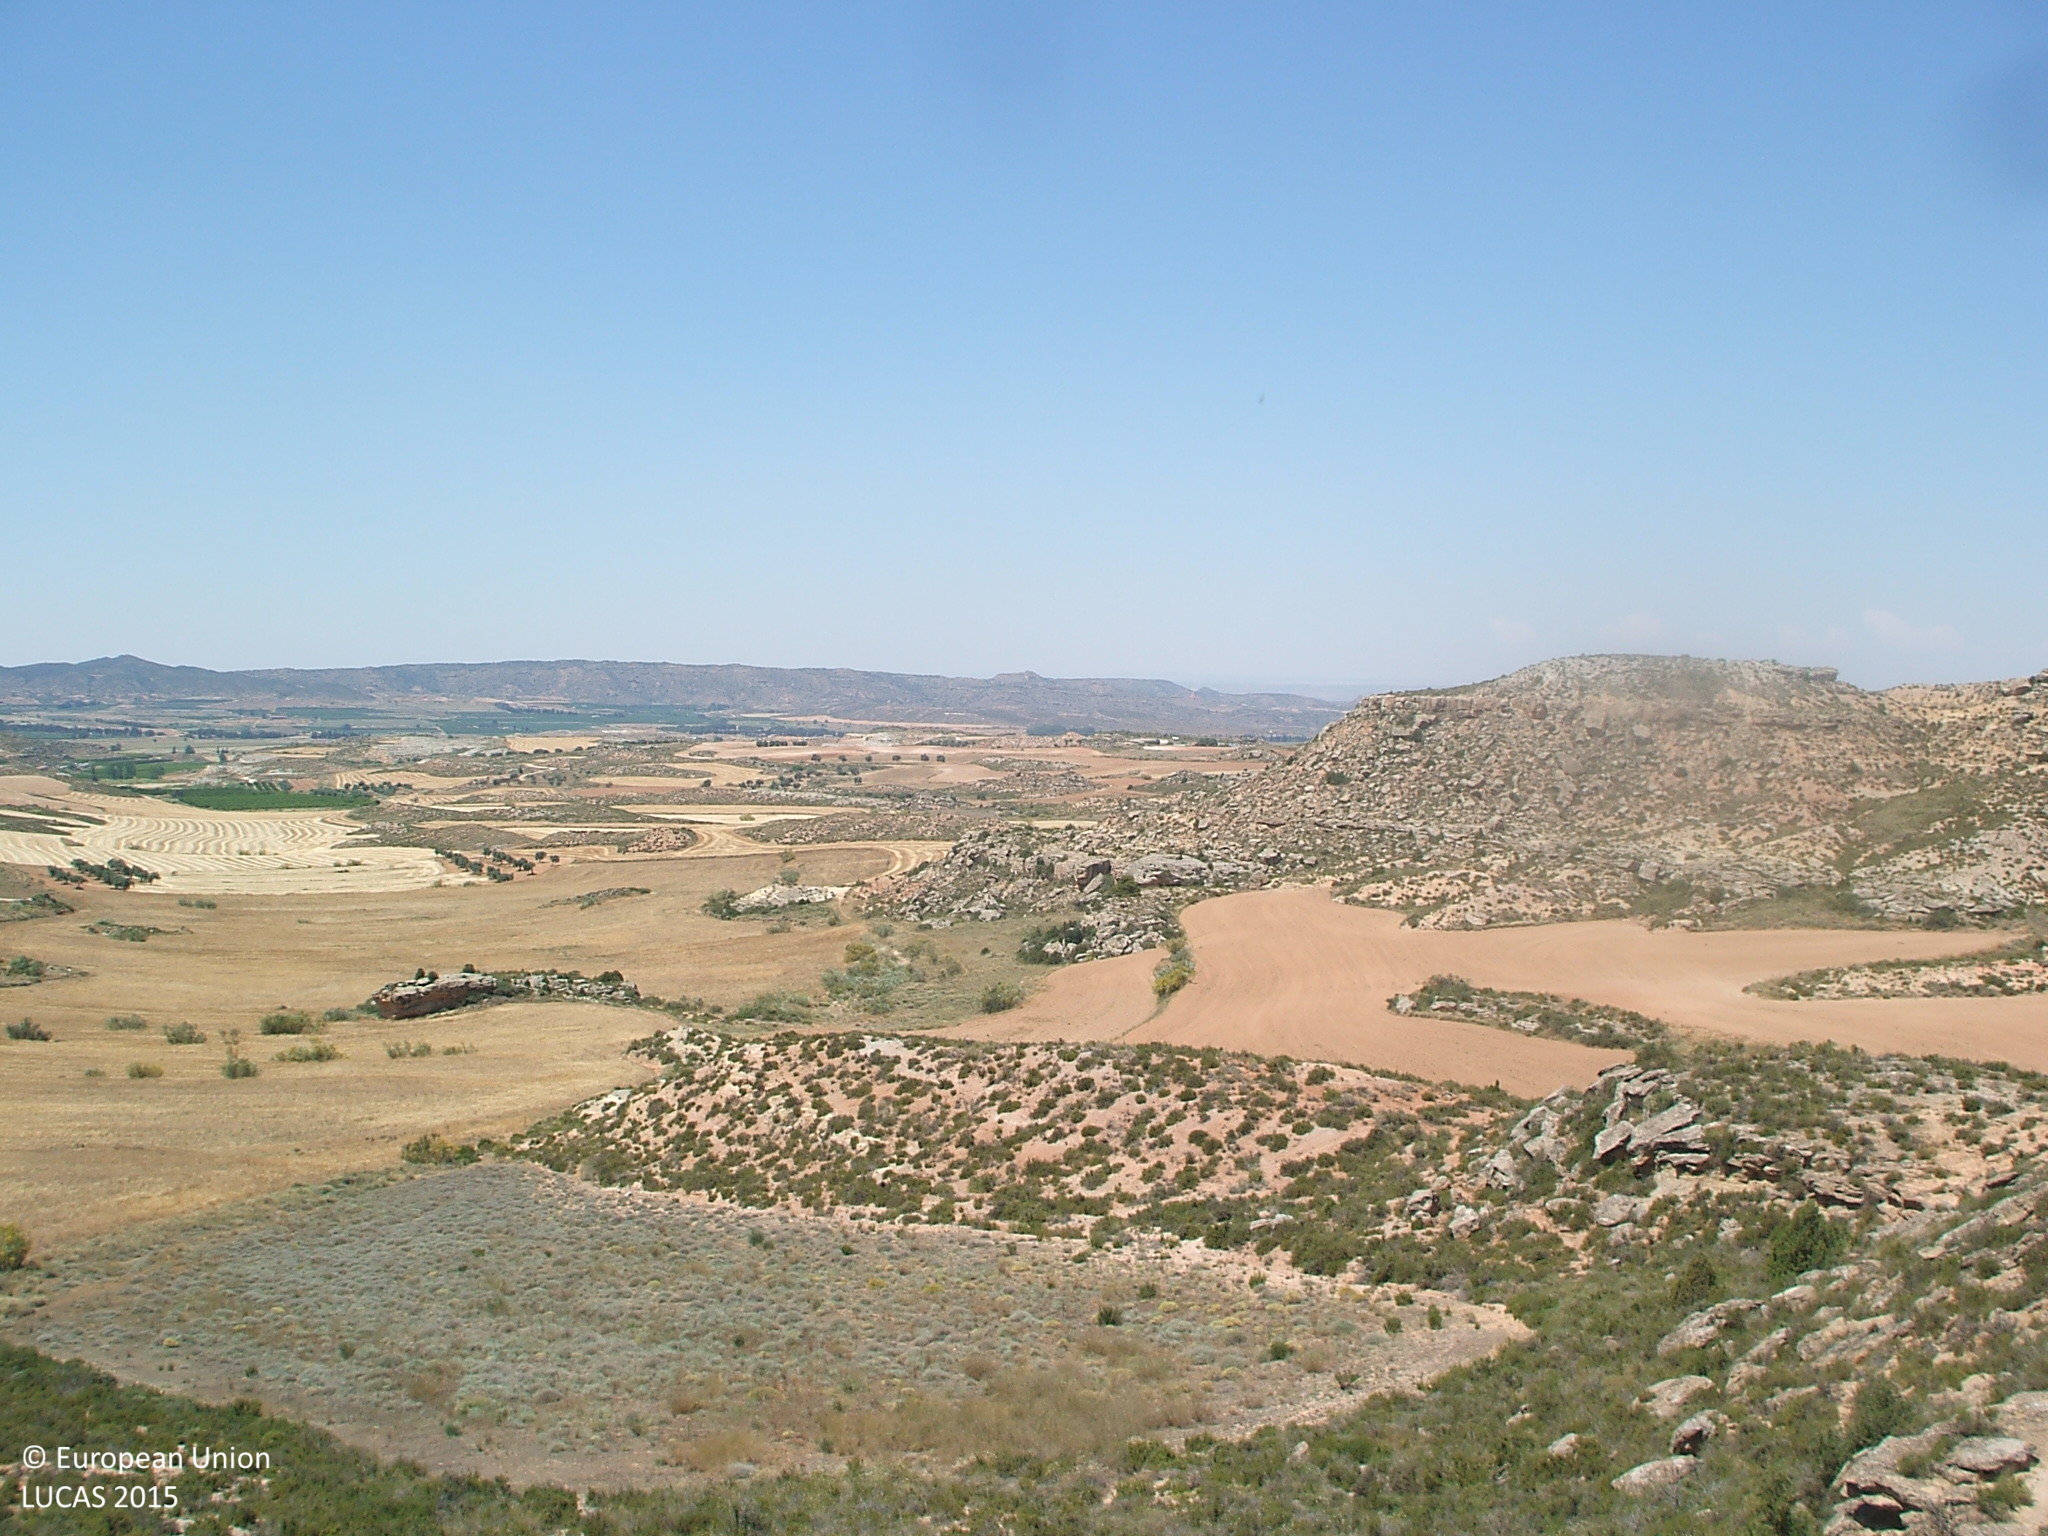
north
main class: Shrubland
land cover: Shrubland without tree cover
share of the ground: 10 - 25 %
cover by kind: consolidated bare surface 80 %, shrubs 20 %
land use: Semi-natural and natural areas not in use
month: June
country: ES
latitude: 41.0834
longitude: -0.1895
